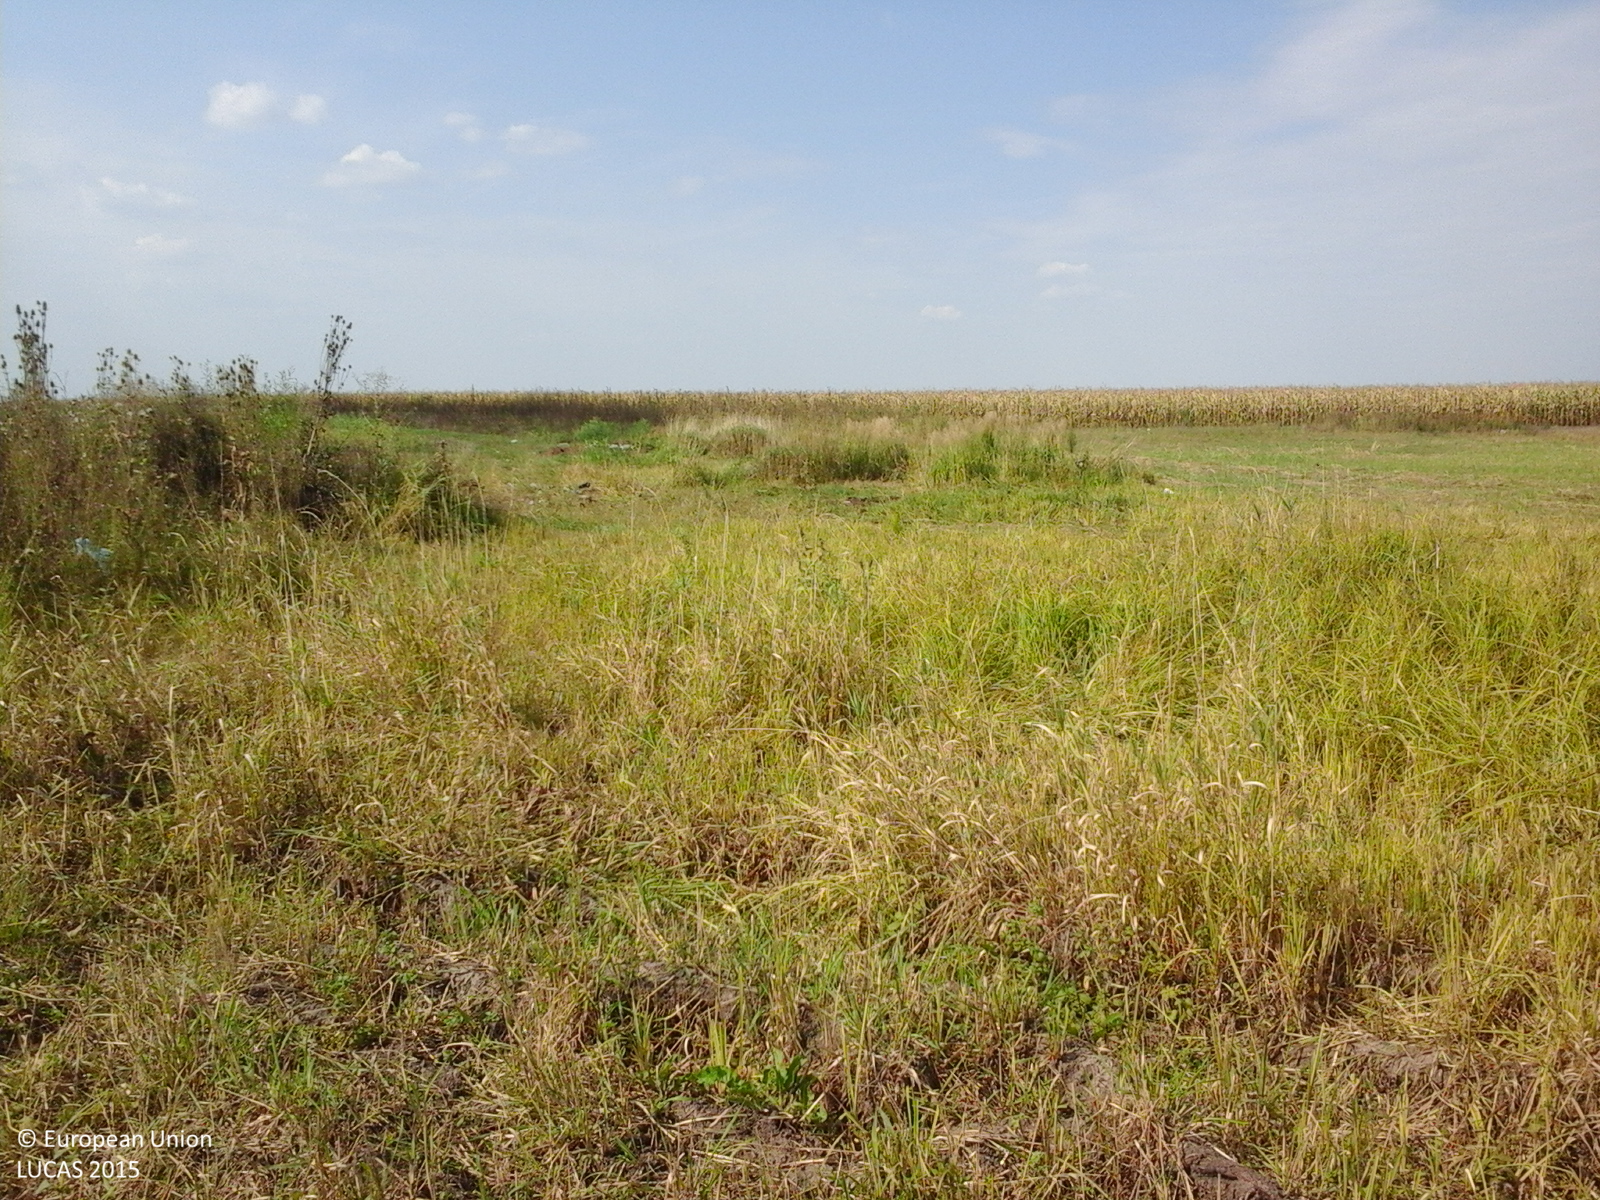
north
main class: Cropland
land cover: Common wheat
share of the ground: < 10 %
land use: Agriculture (excluding fallow land and kitchen gardens)
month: August
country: RO
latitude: 46.3964
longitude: 21.5478
